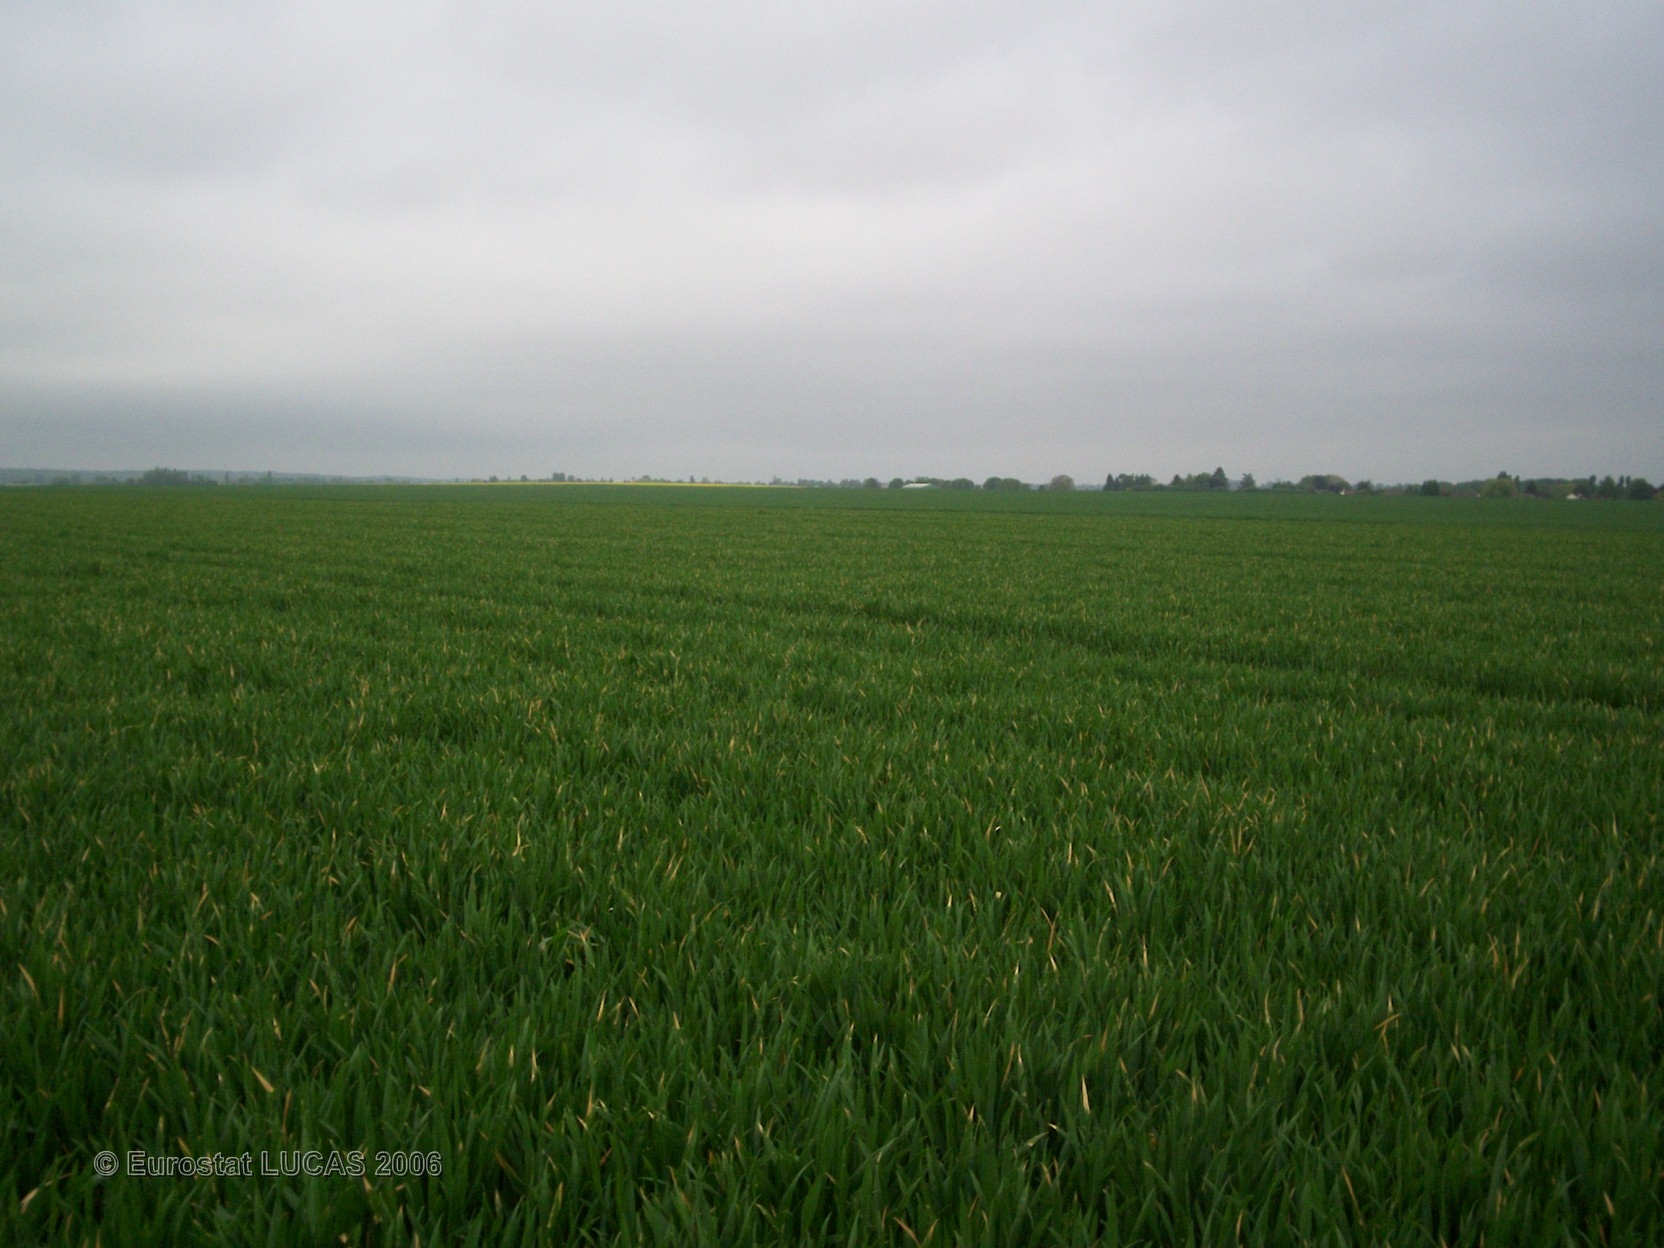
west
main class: Cropland
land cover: Common wheat
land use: Agriculture (excluding fallow land and kitchen gardens)
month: May
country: FR
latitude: 49.2648
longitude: 0.9768
